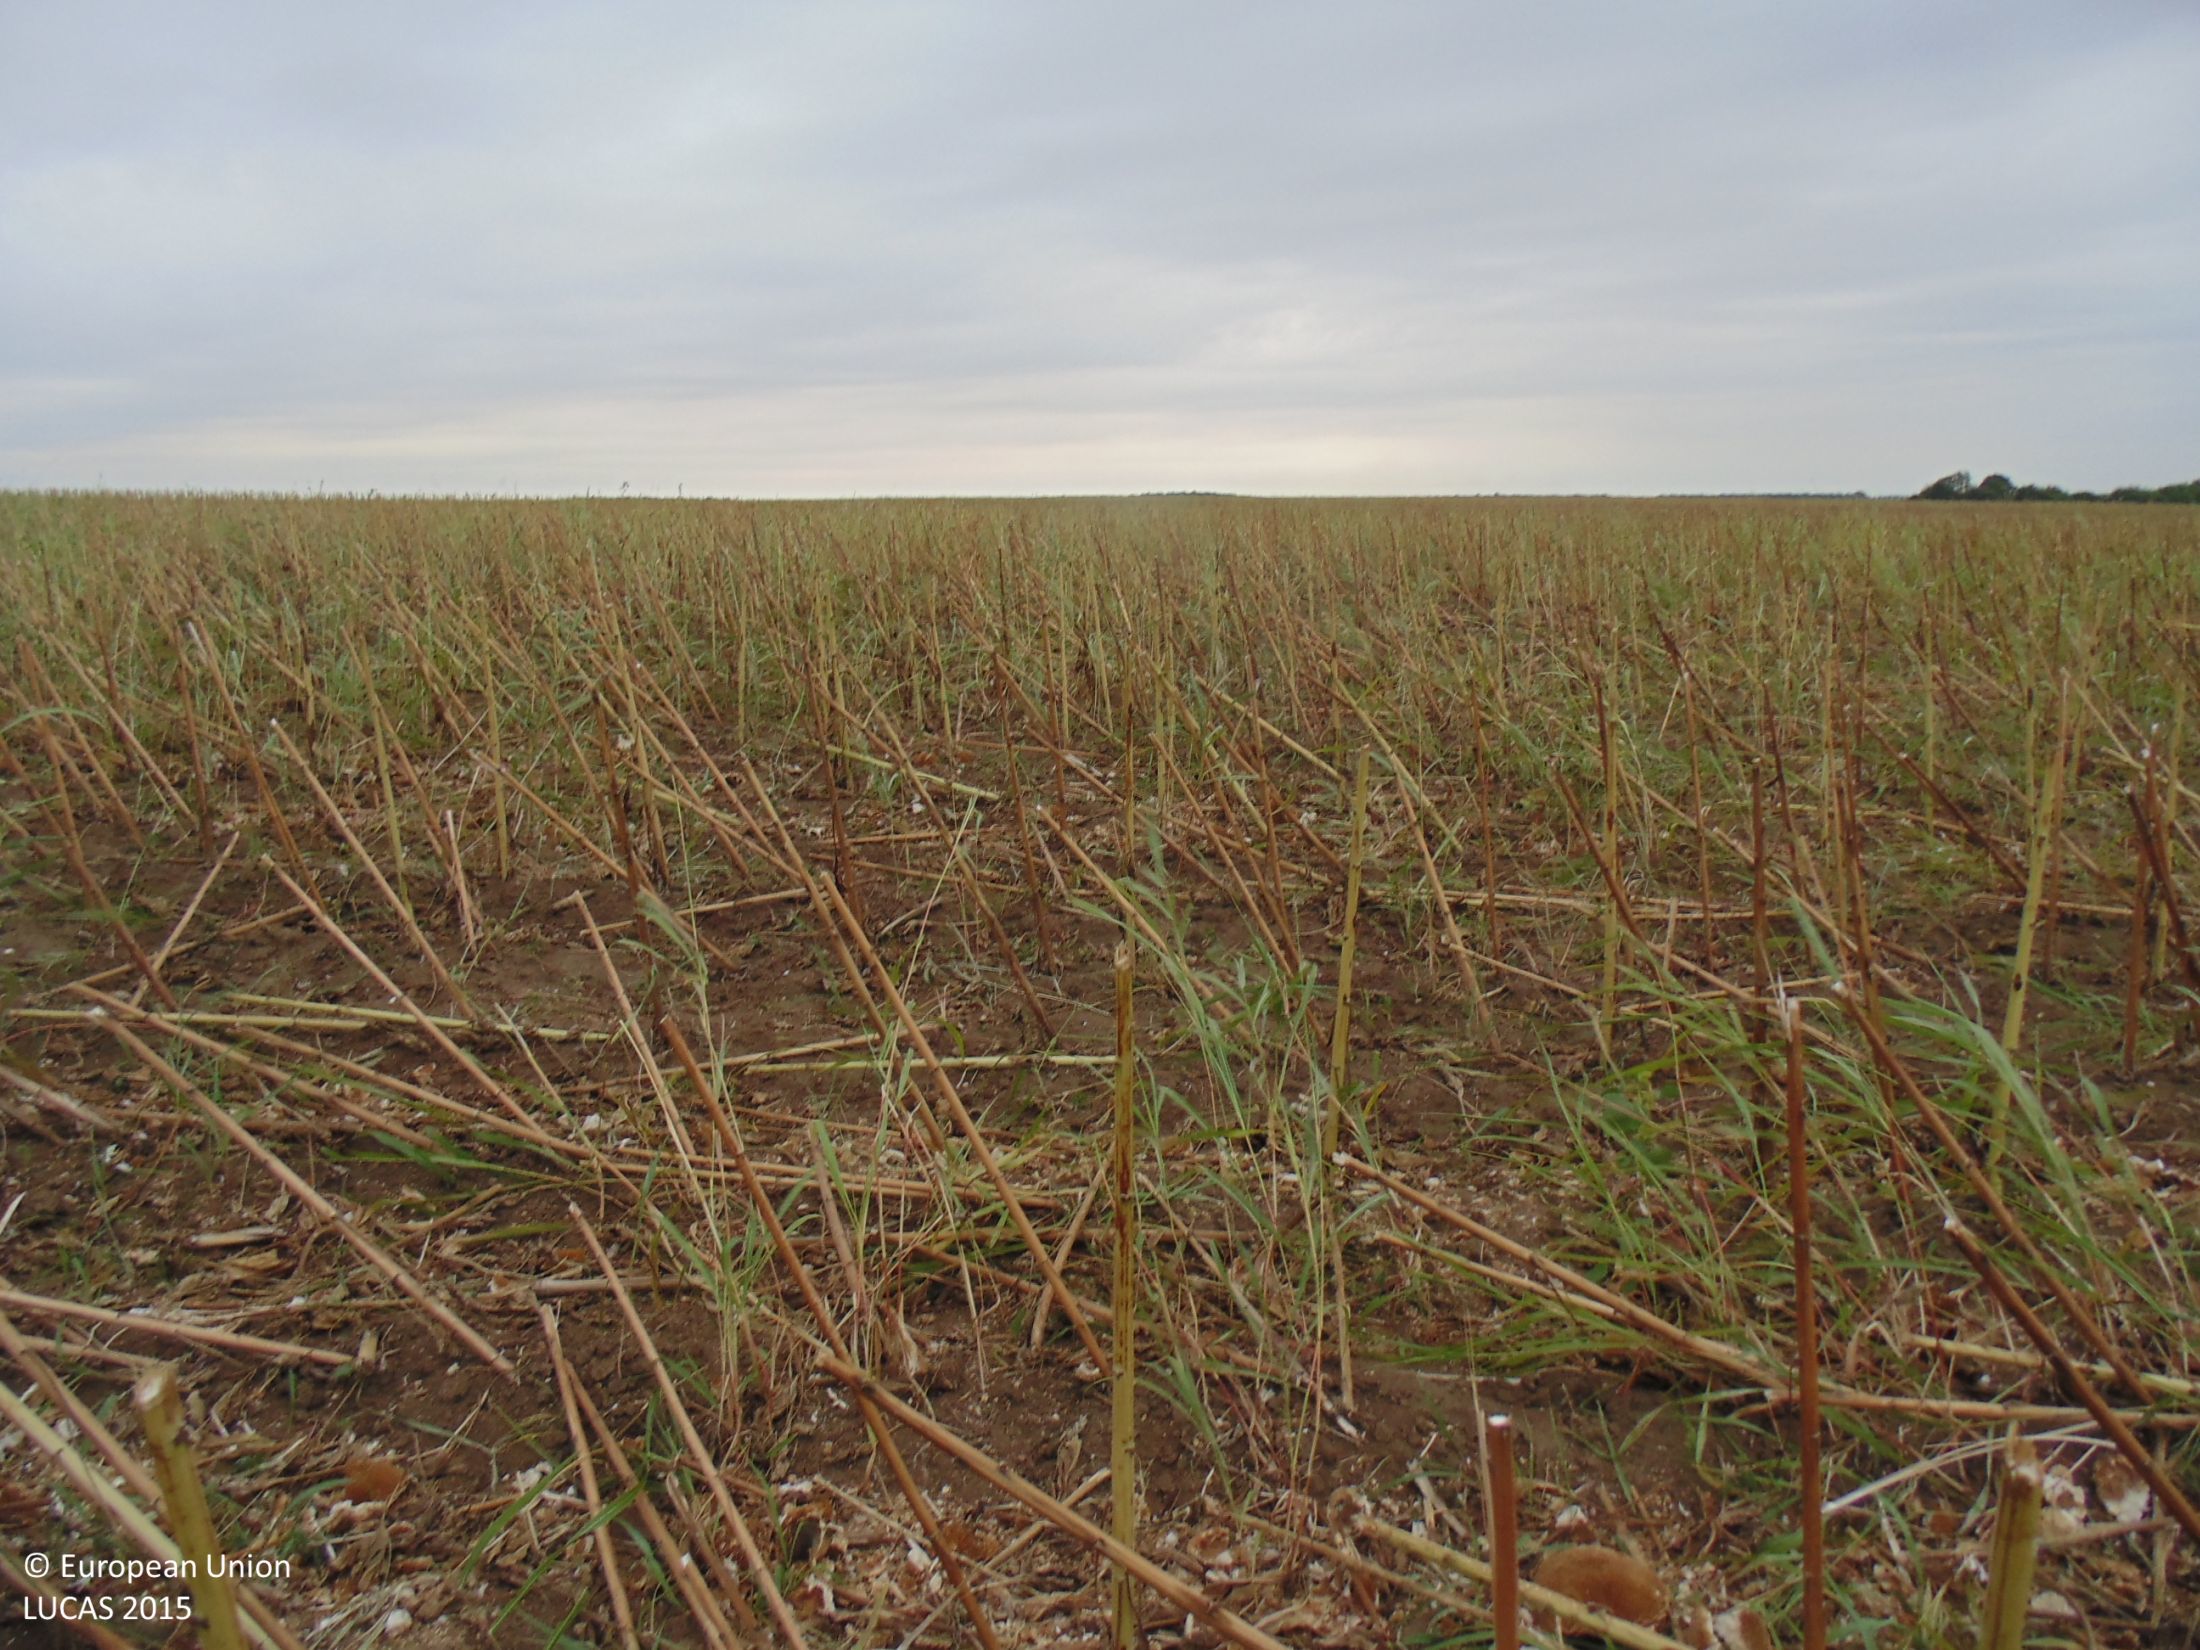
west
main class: Cropland
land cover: Sunflower
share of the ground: 10 - 25 %
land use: Agriculture (excluding fallow land and kitchen gardens)
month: September
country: BG
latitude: 44.0232
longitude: 26.8752
